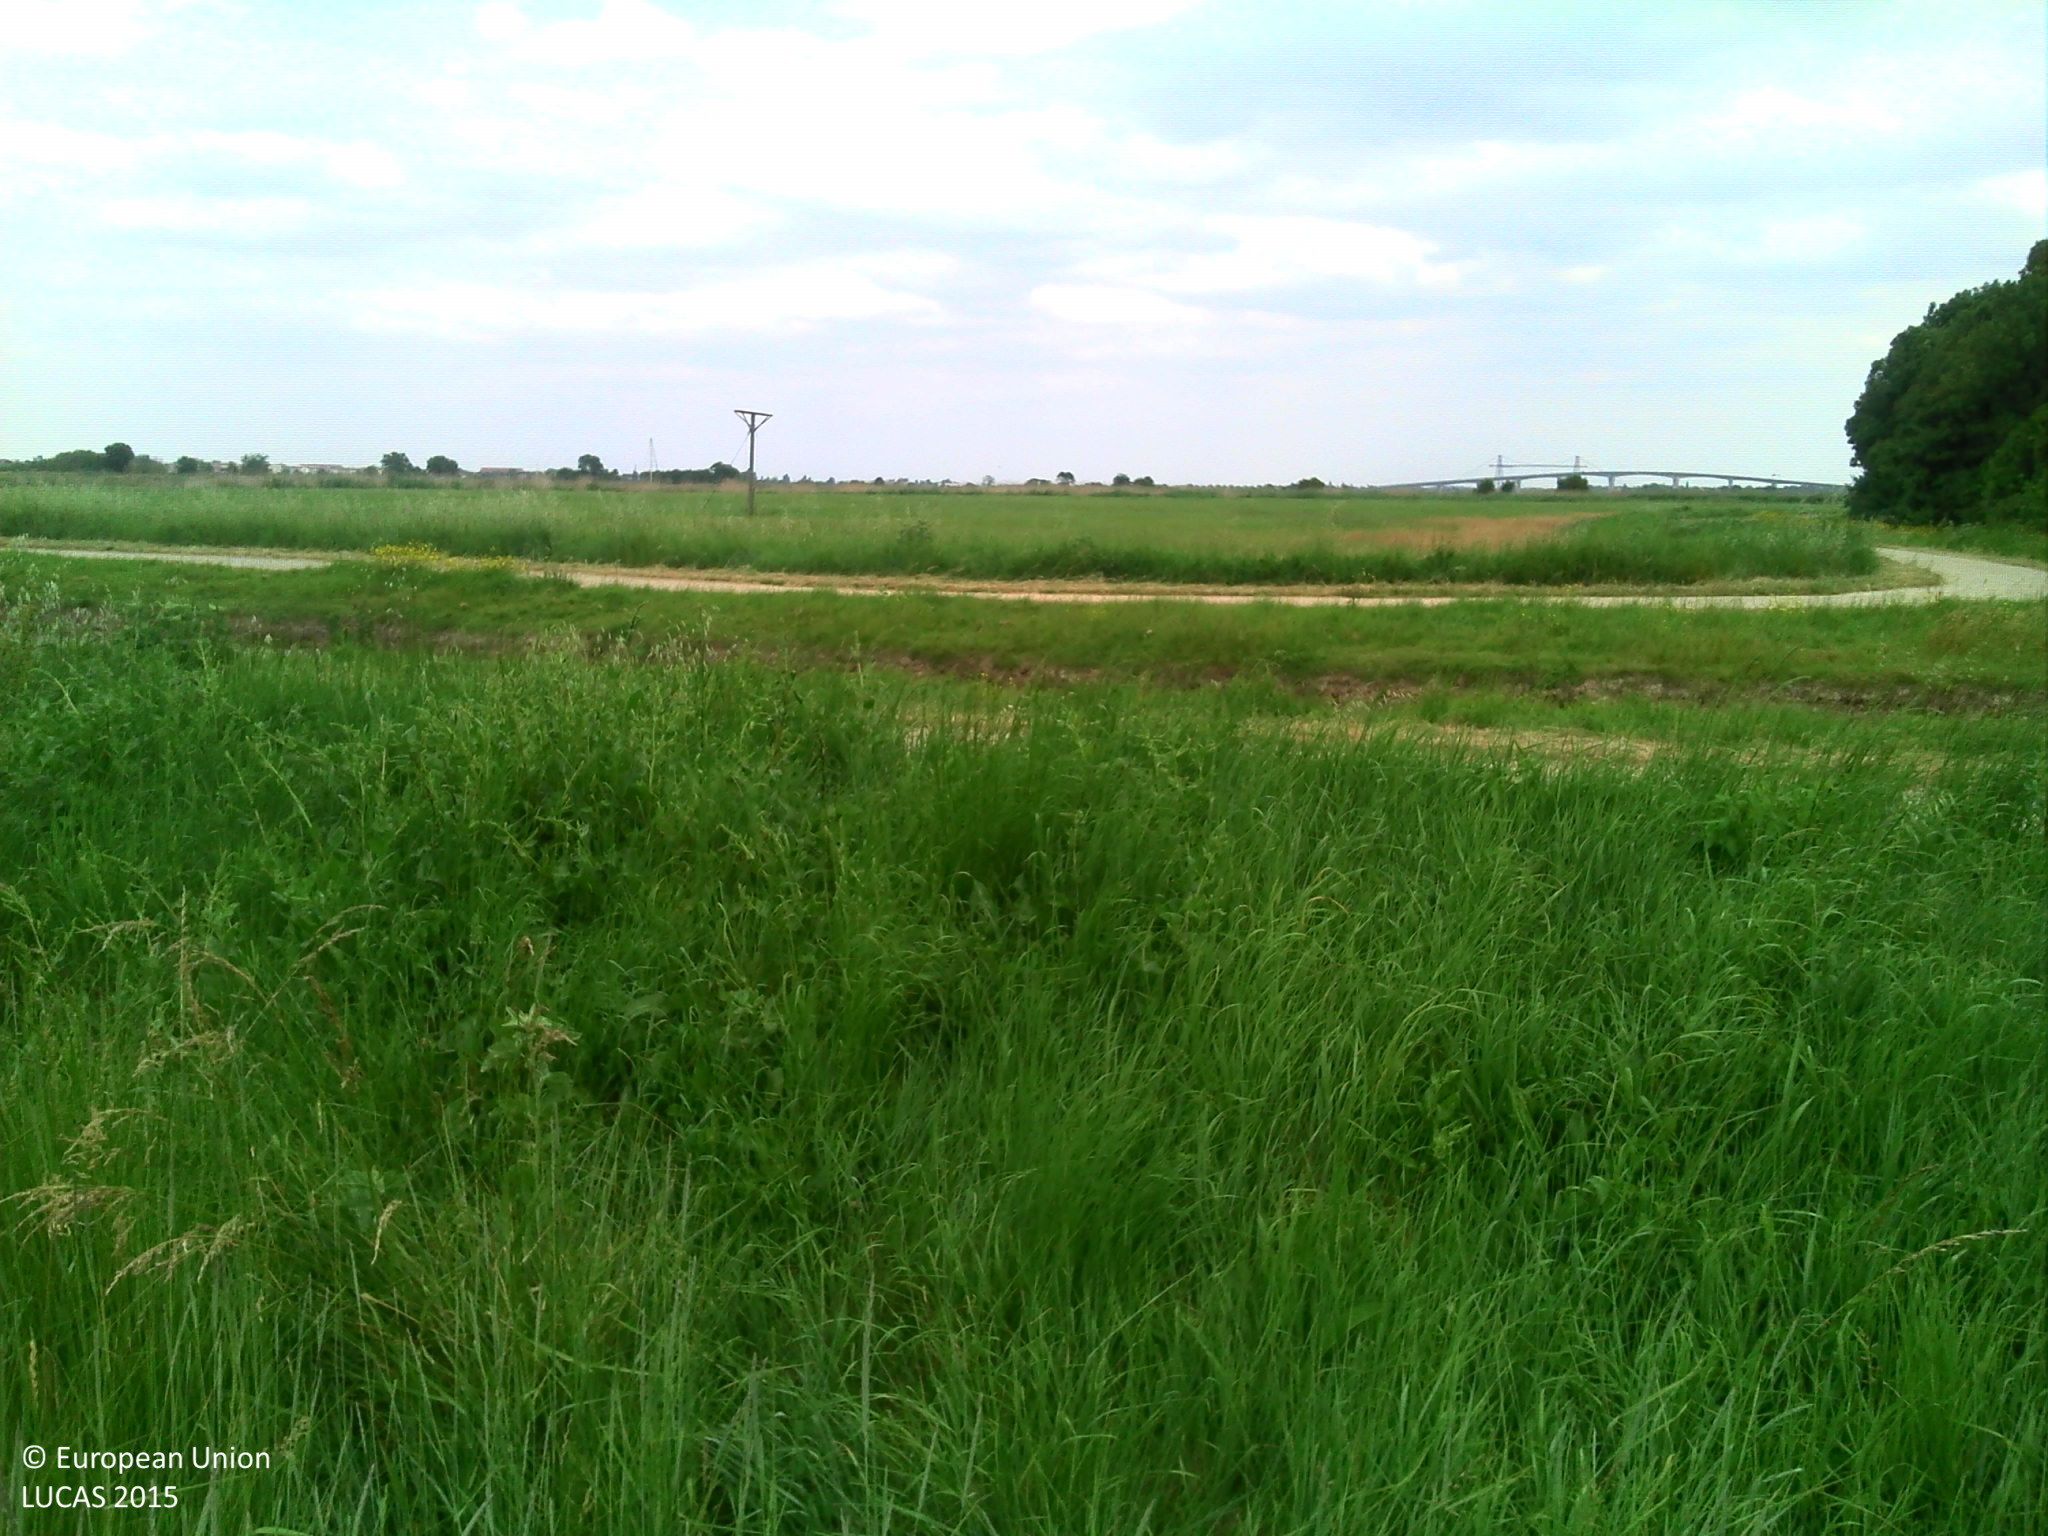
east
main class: Grassland
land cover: Grassland without tree/shrub cover
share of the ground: > 75 %
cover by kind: herbaceous plants 95 %, shrubs 5 %
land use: Agriculture (excluding fallow land and kitchen gardens)
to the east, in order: Grassland without tree/shrub cover; Grass margins; Tracks; Grass margins; Inland fresh running water; Grass margins; Tracks; Grassland without tree/shrub cover
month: June
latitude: 45.9271
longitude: -1.0031
